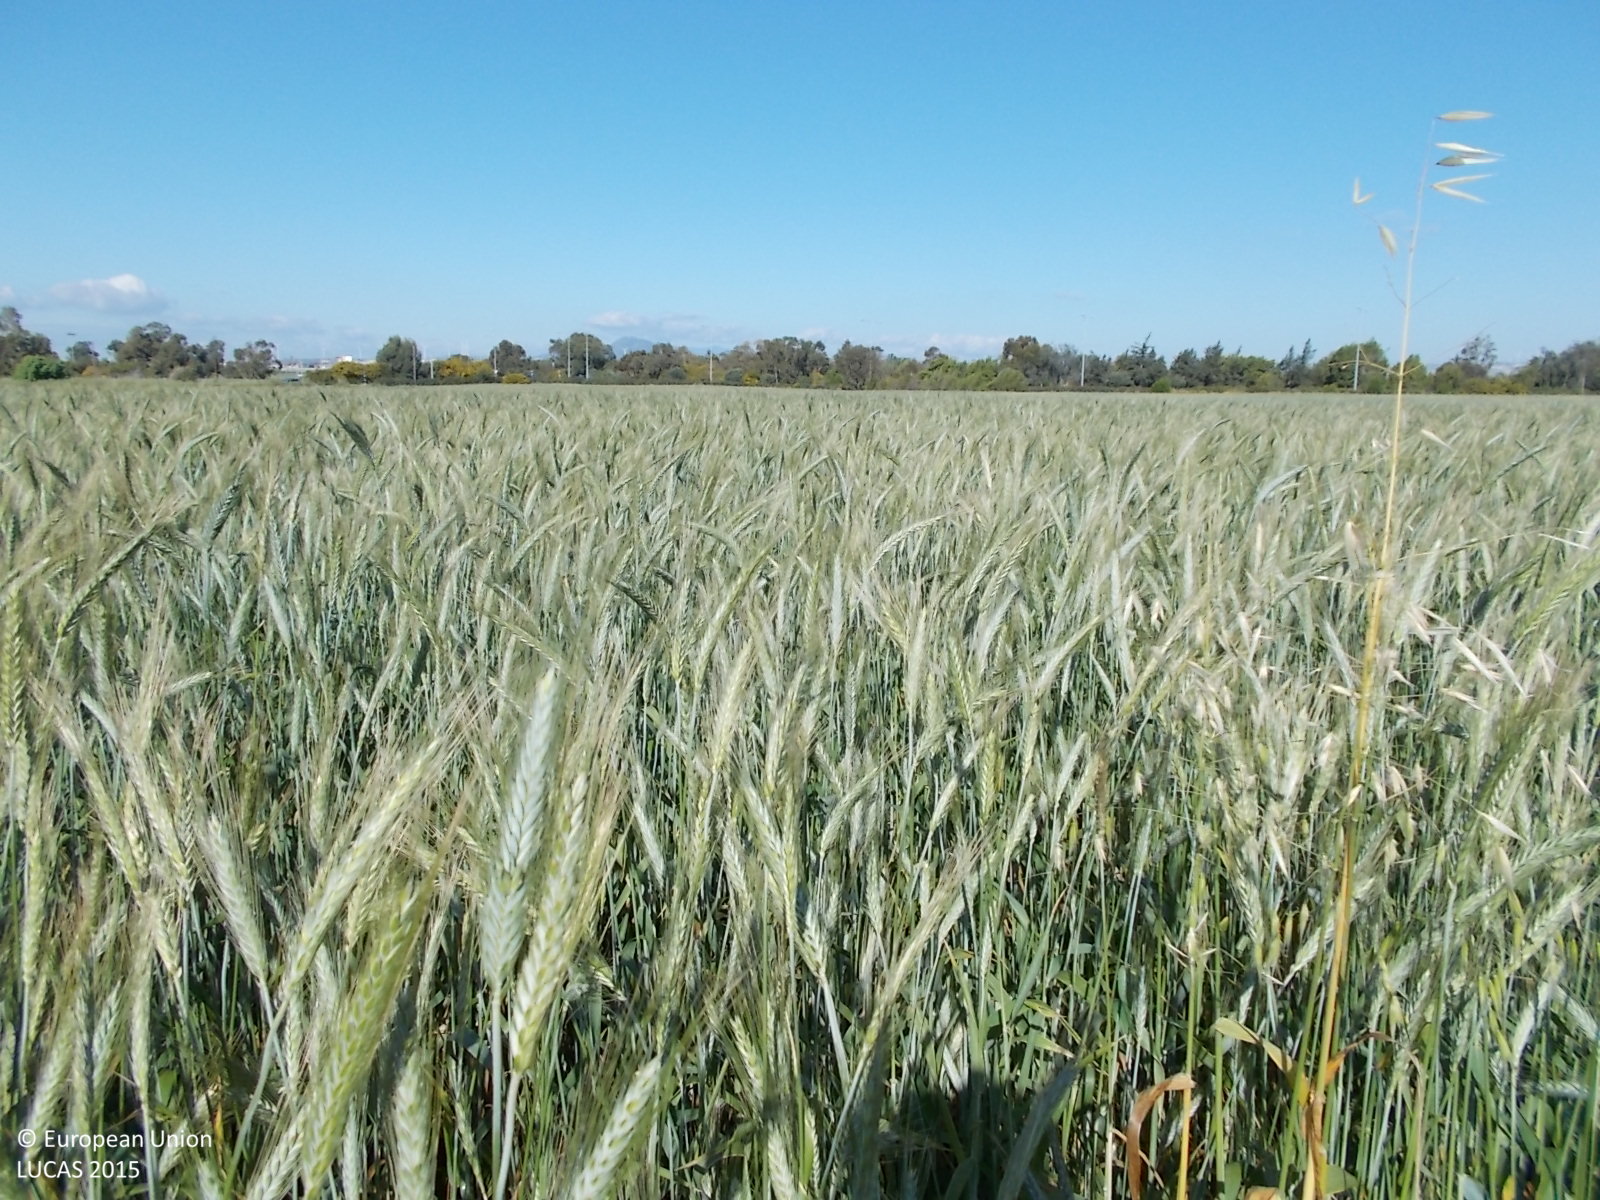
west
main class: Cropland
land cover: Common wheat
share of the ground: > 75 %
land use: Agriculture (excluding fallow land and kitchen gardens)
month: April
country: CY
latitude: 34.8777
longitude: 33.6182
